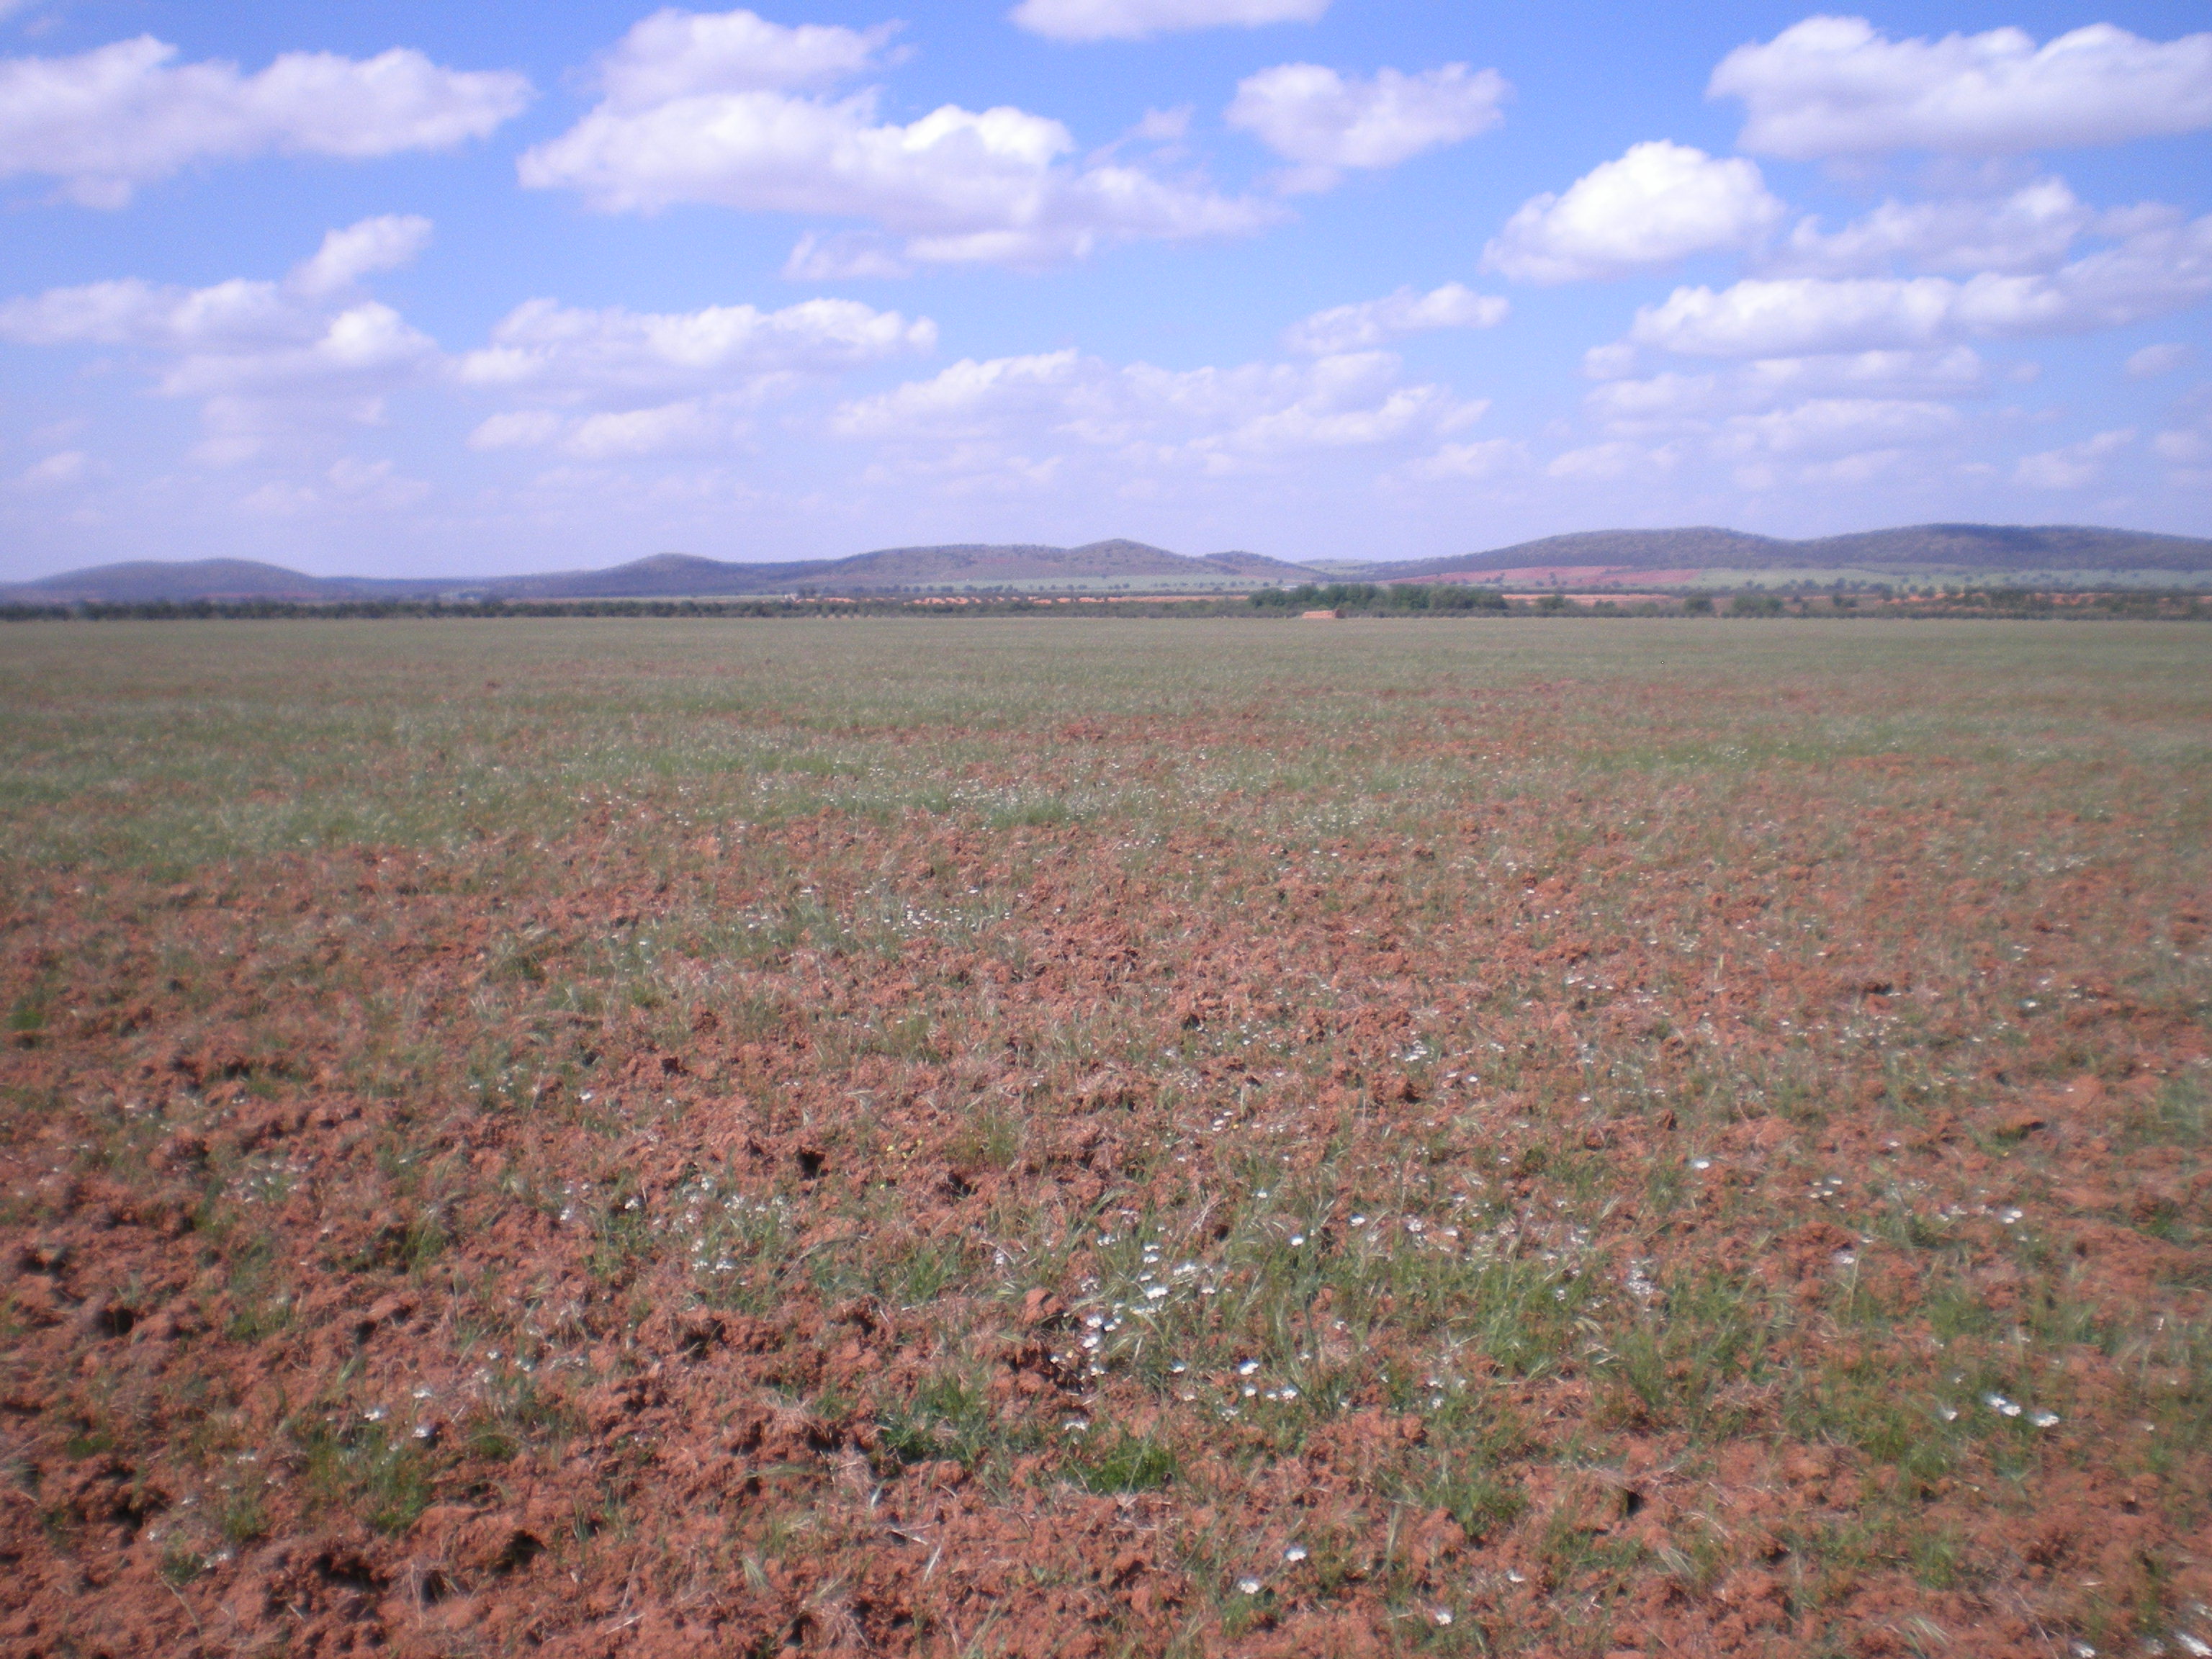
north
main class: Grassland
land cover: Spontaneously vegetated surfaces
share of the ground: 25 - 50 %
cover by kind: unconsolidated bare surface 70 %, herbaceous plants 30 %
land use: Fallow land
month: April
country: ES
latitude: 38.6822
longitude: -3.5417
